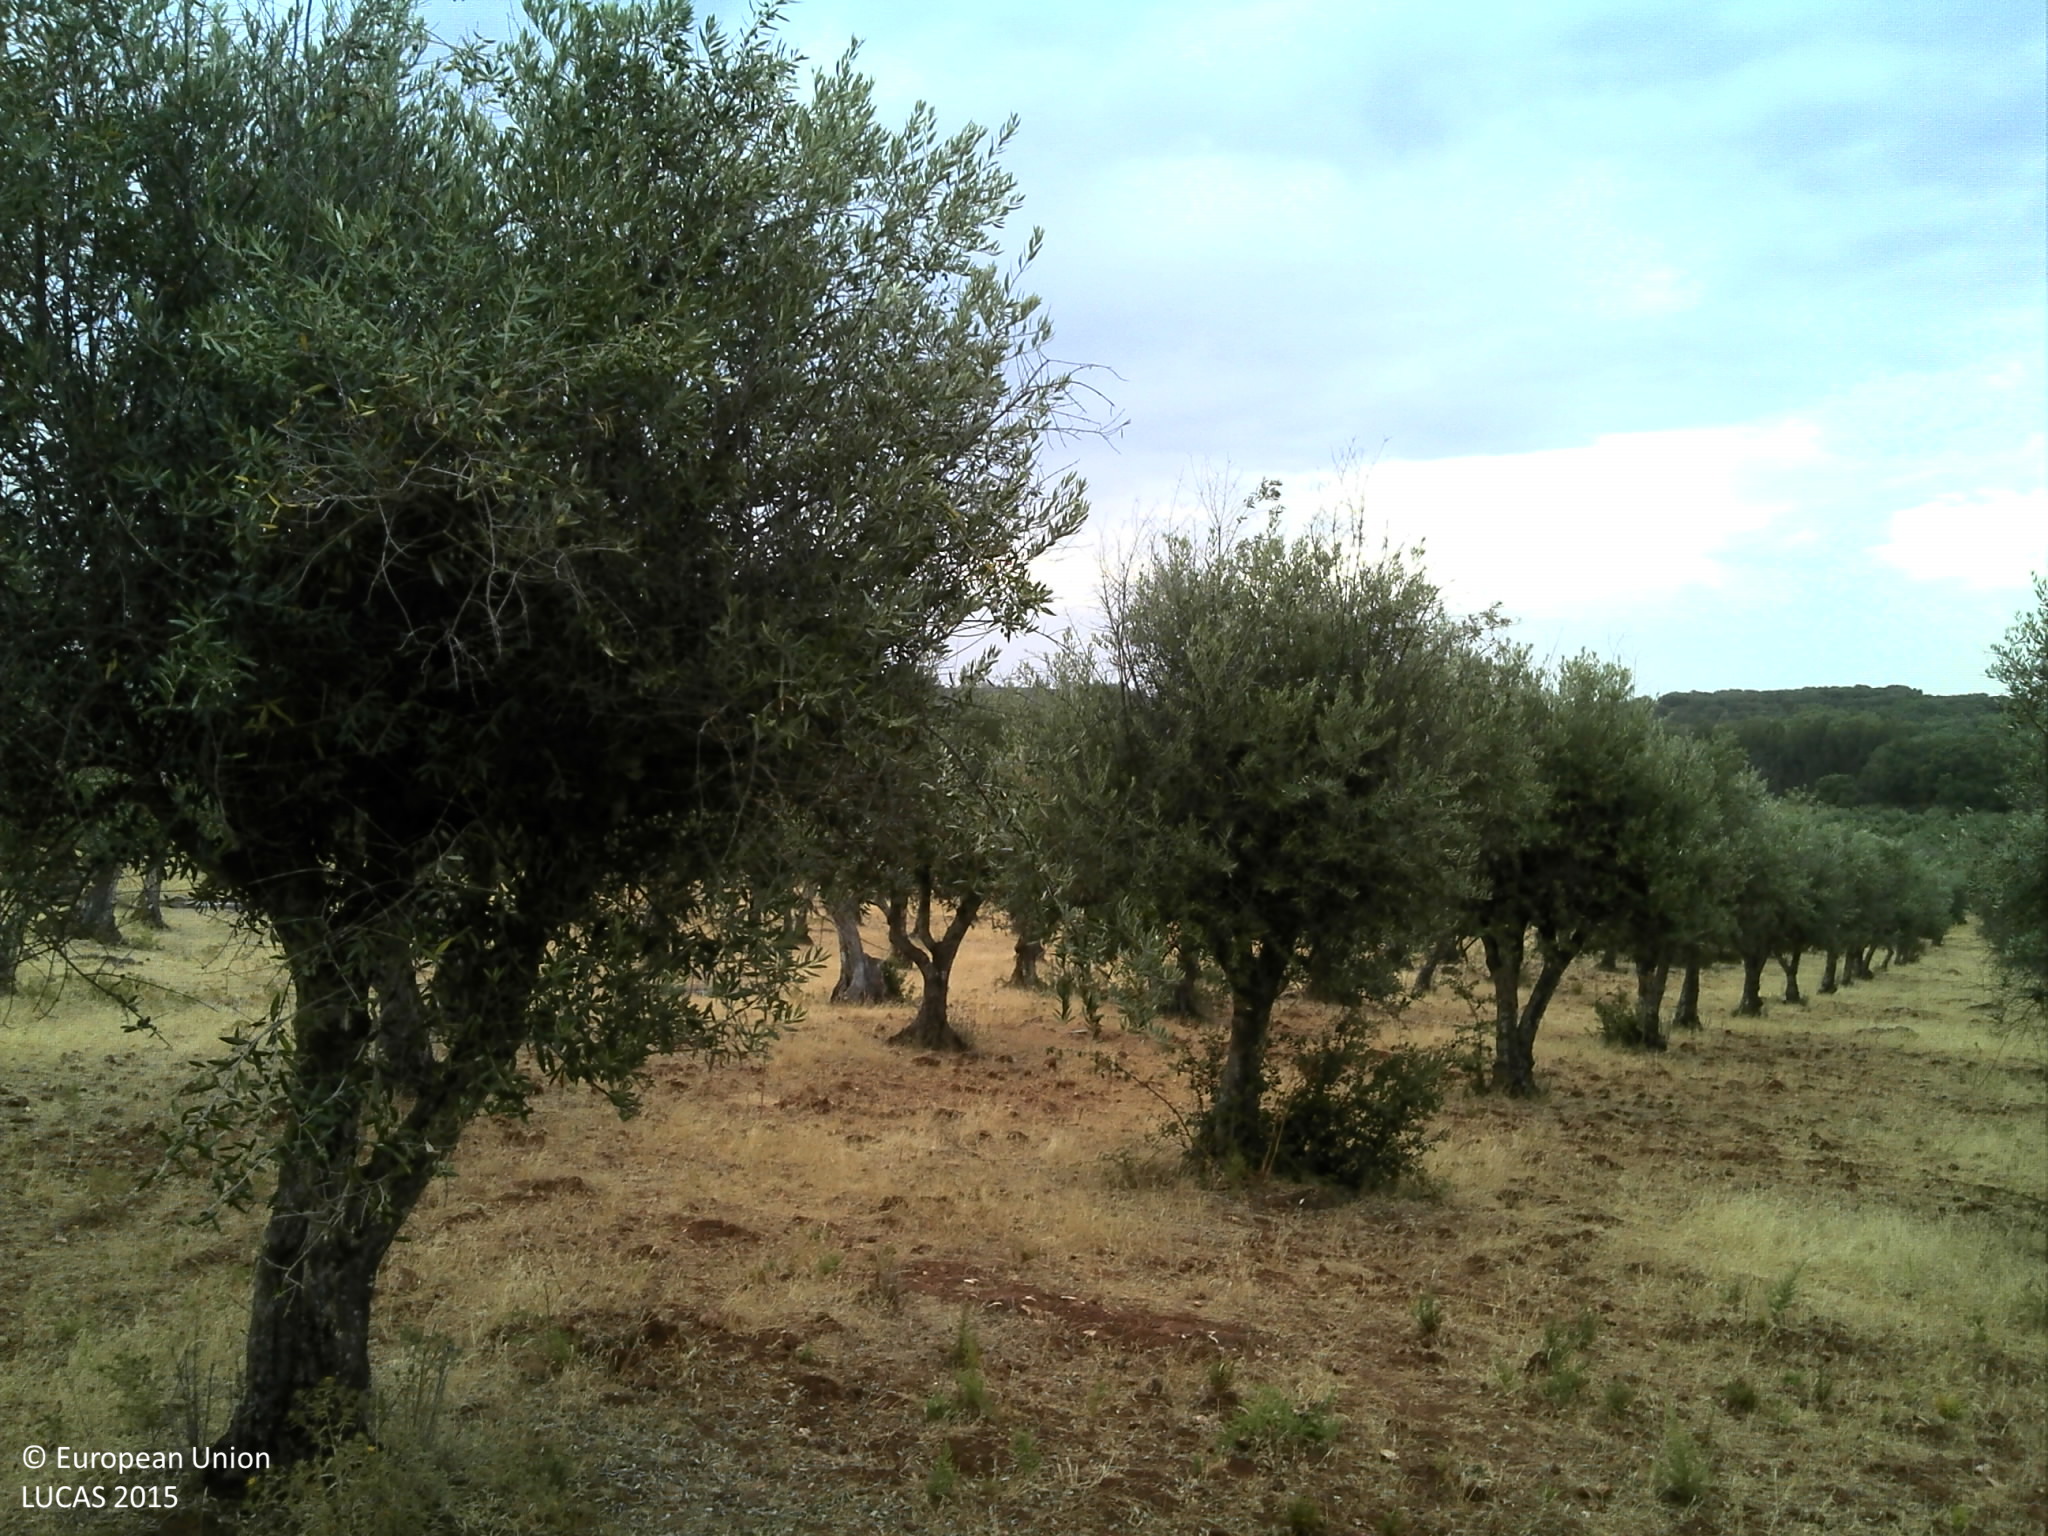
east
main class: Cropland
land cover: Olive groves
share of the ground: 25 - 50 %
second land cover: Grassland without tree/shrub cover
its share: 25 - 50 %
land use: Agriculture (excluding fallow land and kitchen gardens)
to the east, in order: Olive groves; Grassland without tree/shrub cover; Olive groves; Dry stone walls; Grassland without tree/shrub cover; Tracks; Shruby margins; Spontaneously vegetated surfaces; Electric lines; Spontaneously vegetated surfaces
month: July
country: PT
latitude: 38.7915
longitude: -7.4991
